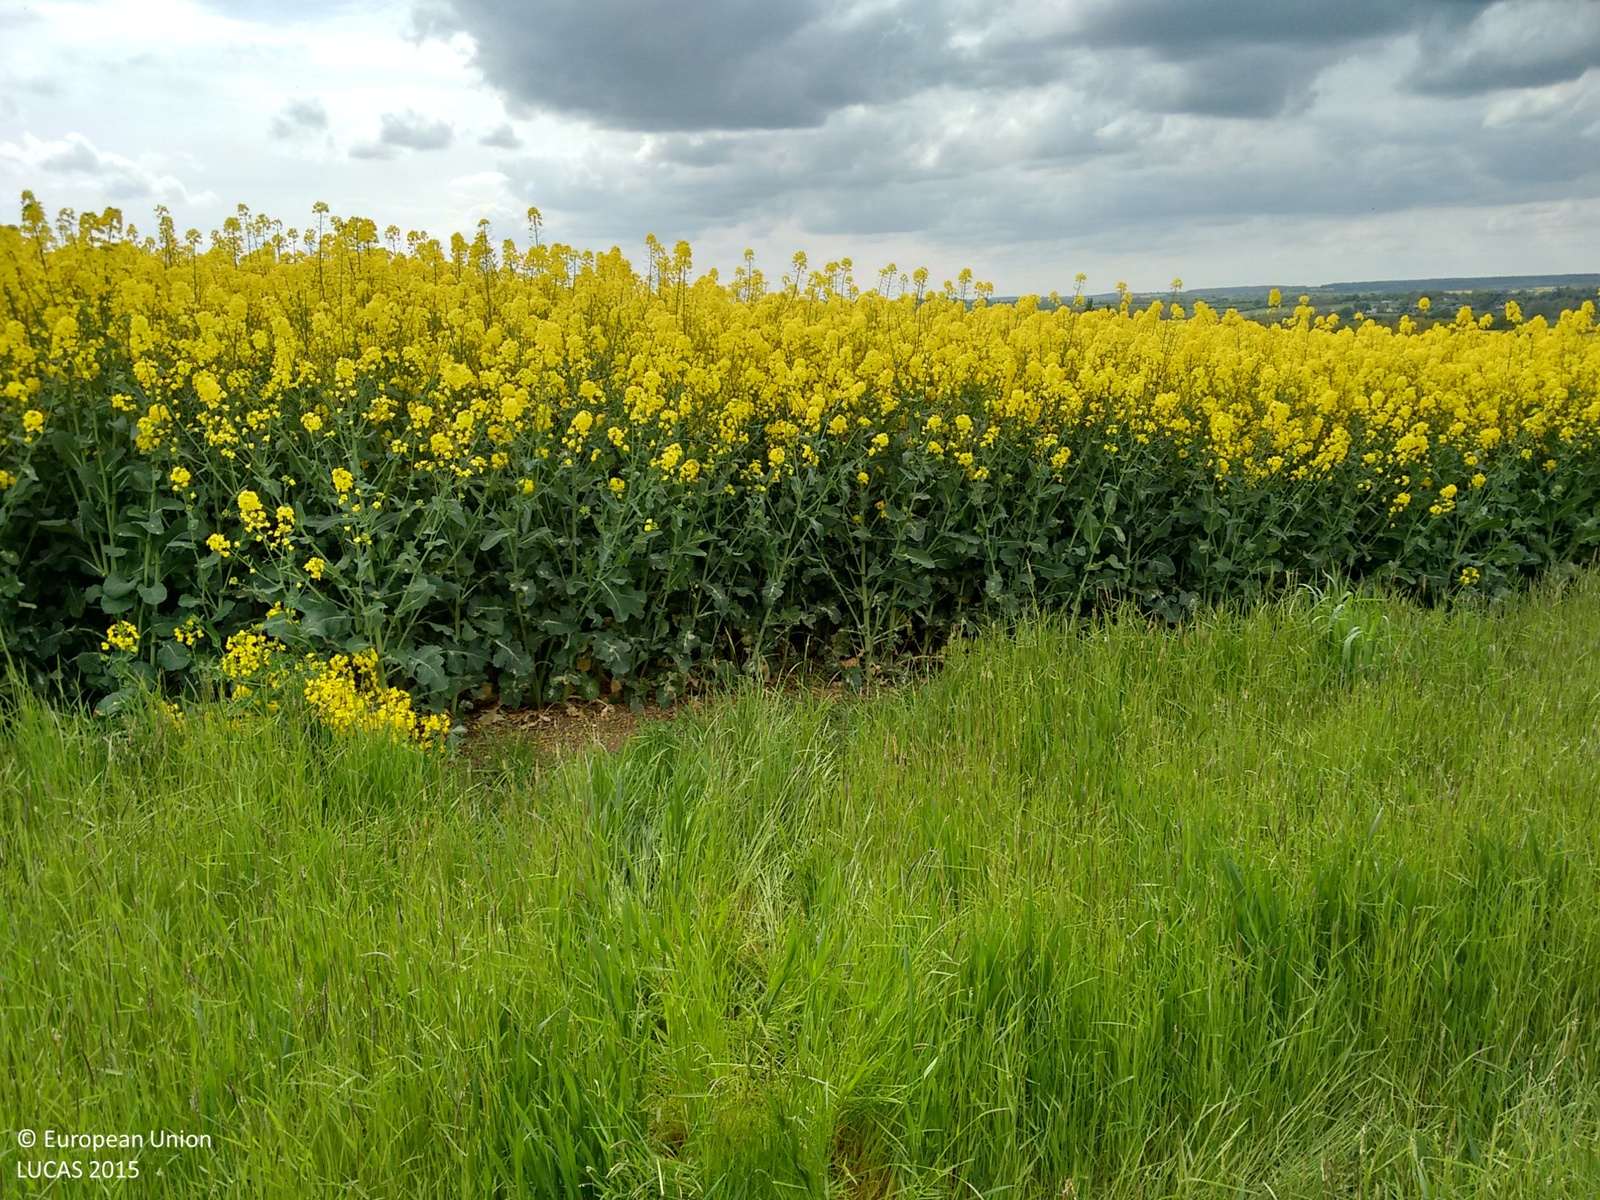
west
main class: Grassland
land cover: Grassland without tree/shrub cover
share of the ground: > 75 %
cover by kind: herbaceous plants 100 %
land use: Agriculture (excluding fallow land and kitchen gardens)
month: May
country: GB
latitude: 52.2007
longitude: -0.4997
